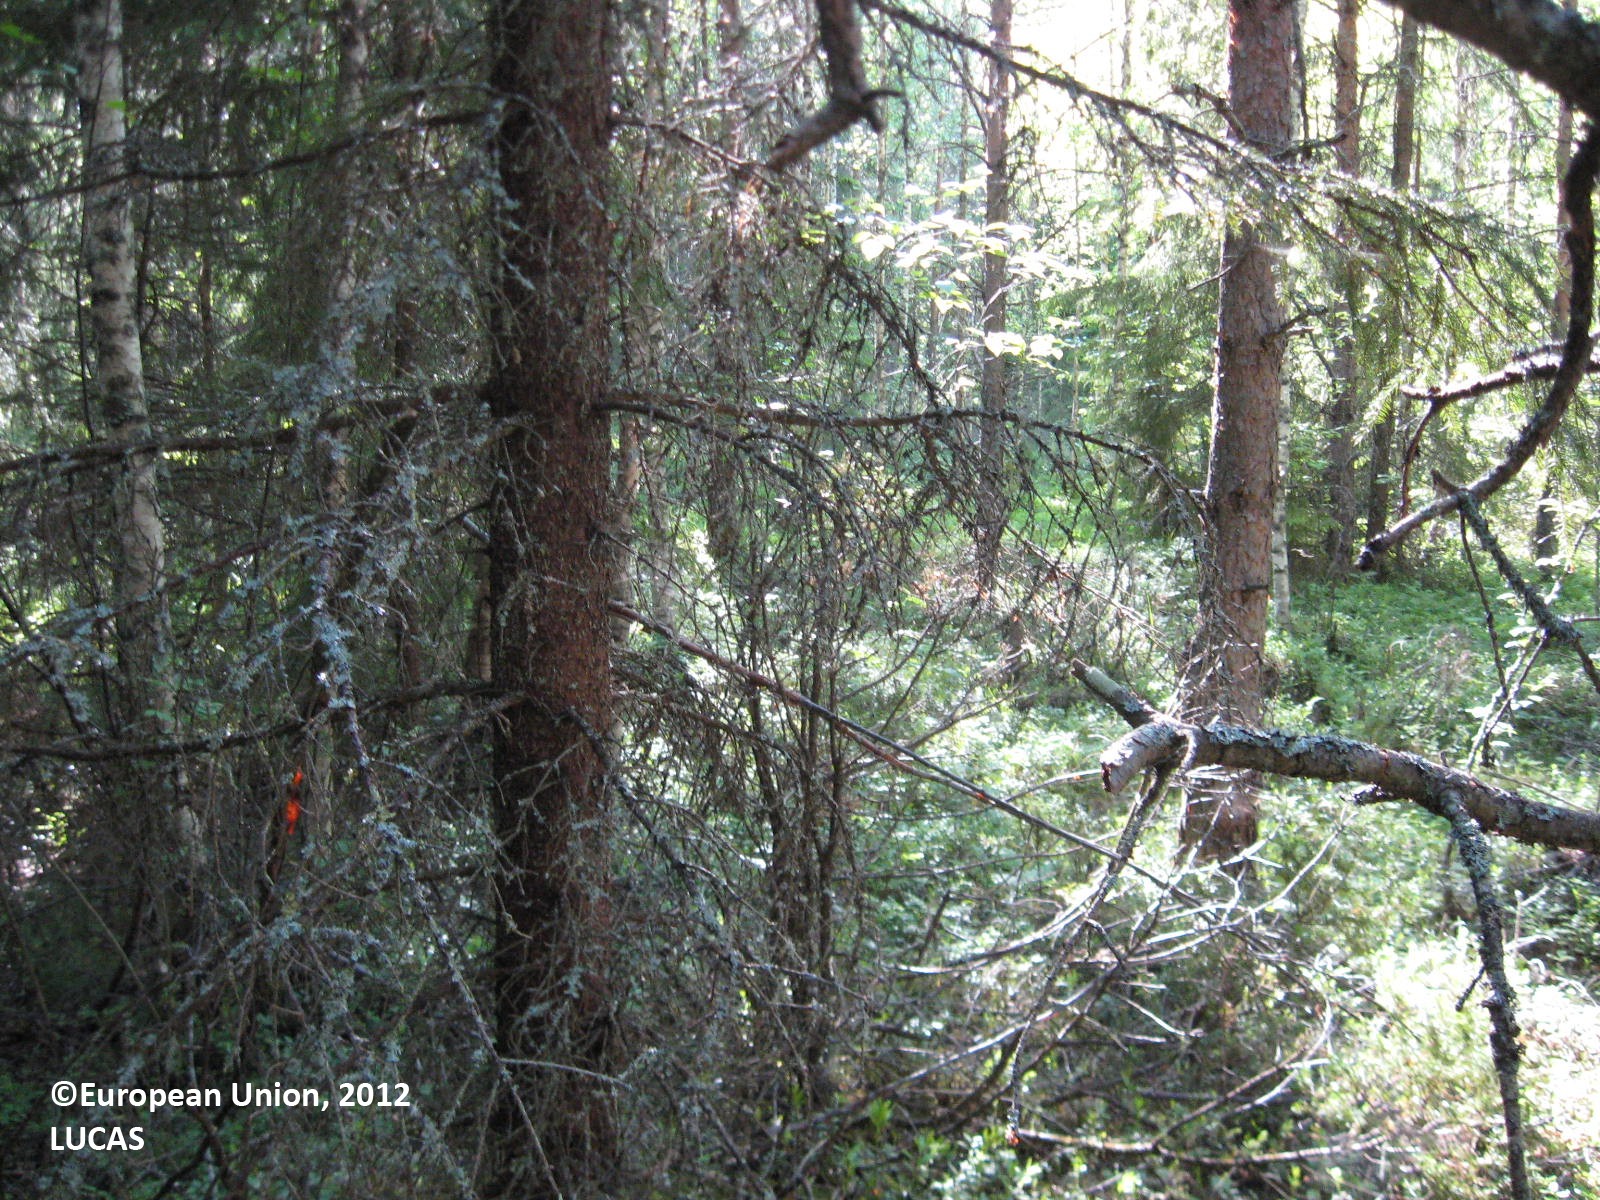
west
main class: Woodland
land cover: Spruce dominated mixed woodland
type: boreal forest
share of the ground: > 75 %
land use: Forestry
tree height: > 5 m
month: June
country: FI
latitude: 62.7490
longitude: 21.5724
